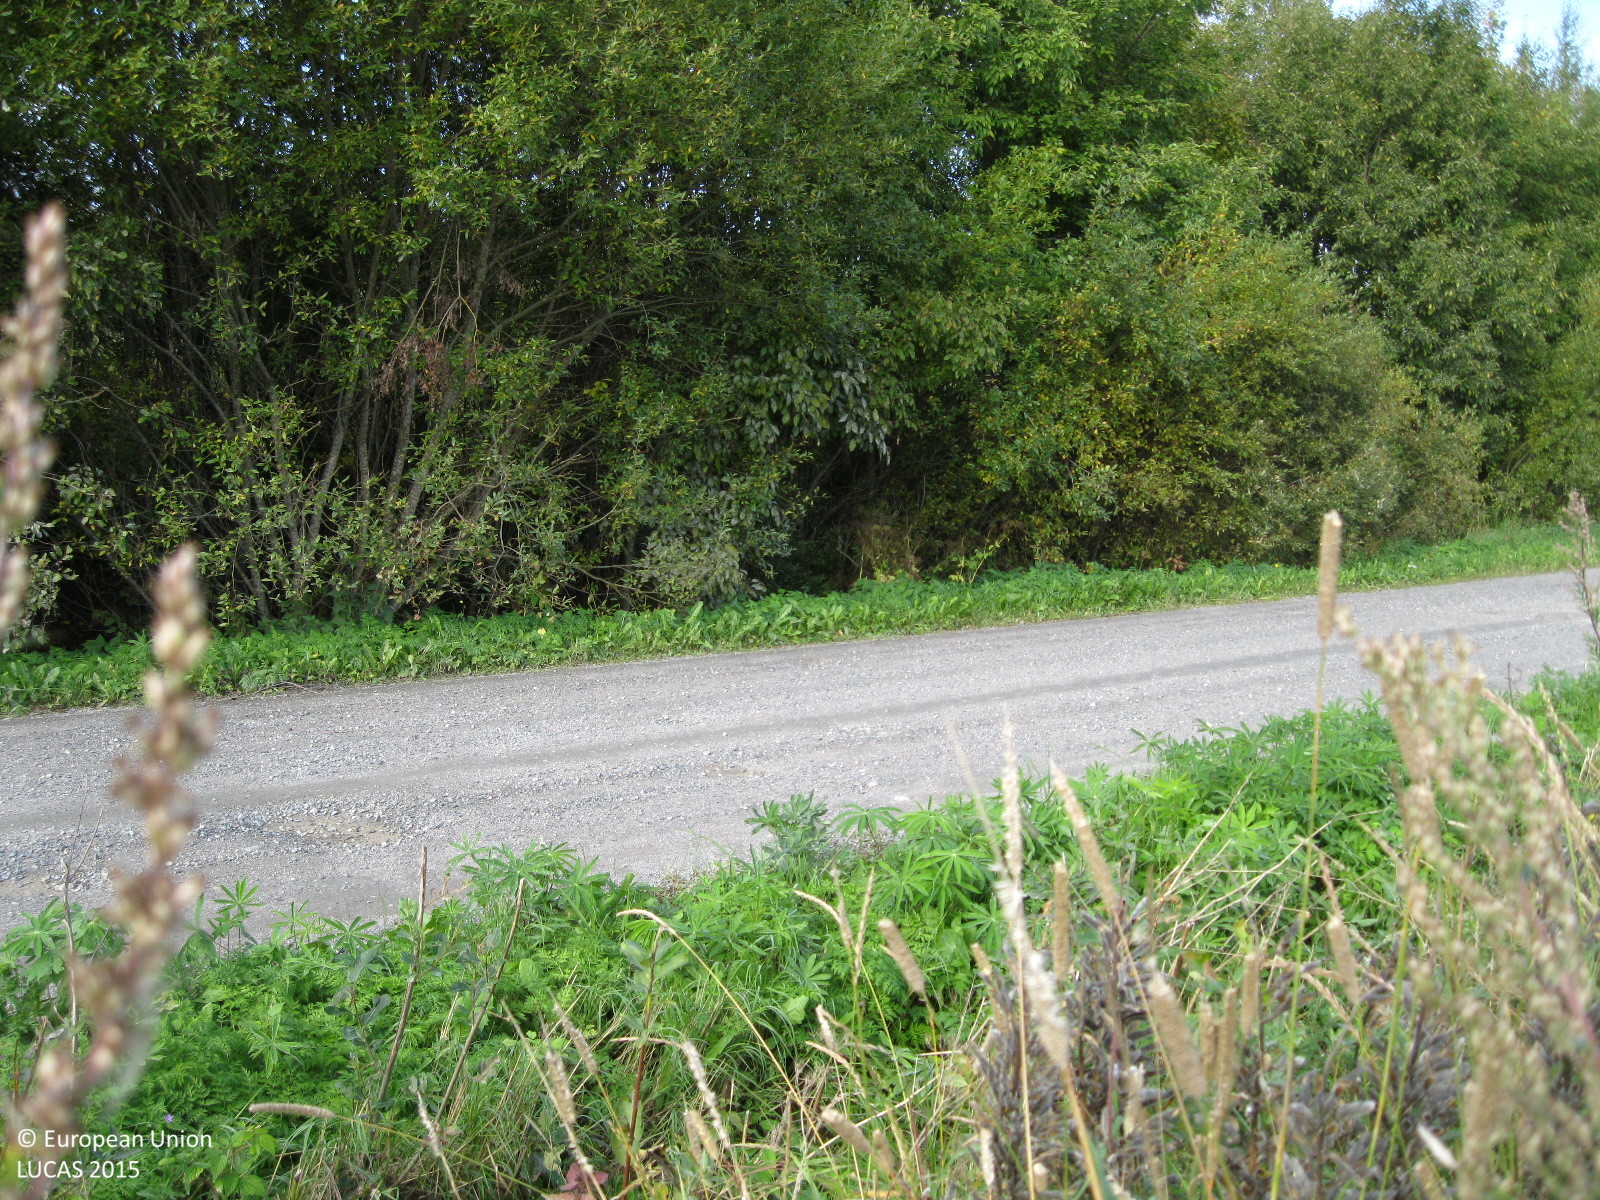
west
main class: Cropland
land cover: Barley
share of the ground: > 75 %
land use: Agriculture (excluding fallow land and kitchen gardens)
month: September
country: FI
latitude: 60.5931
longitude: 24.9221
